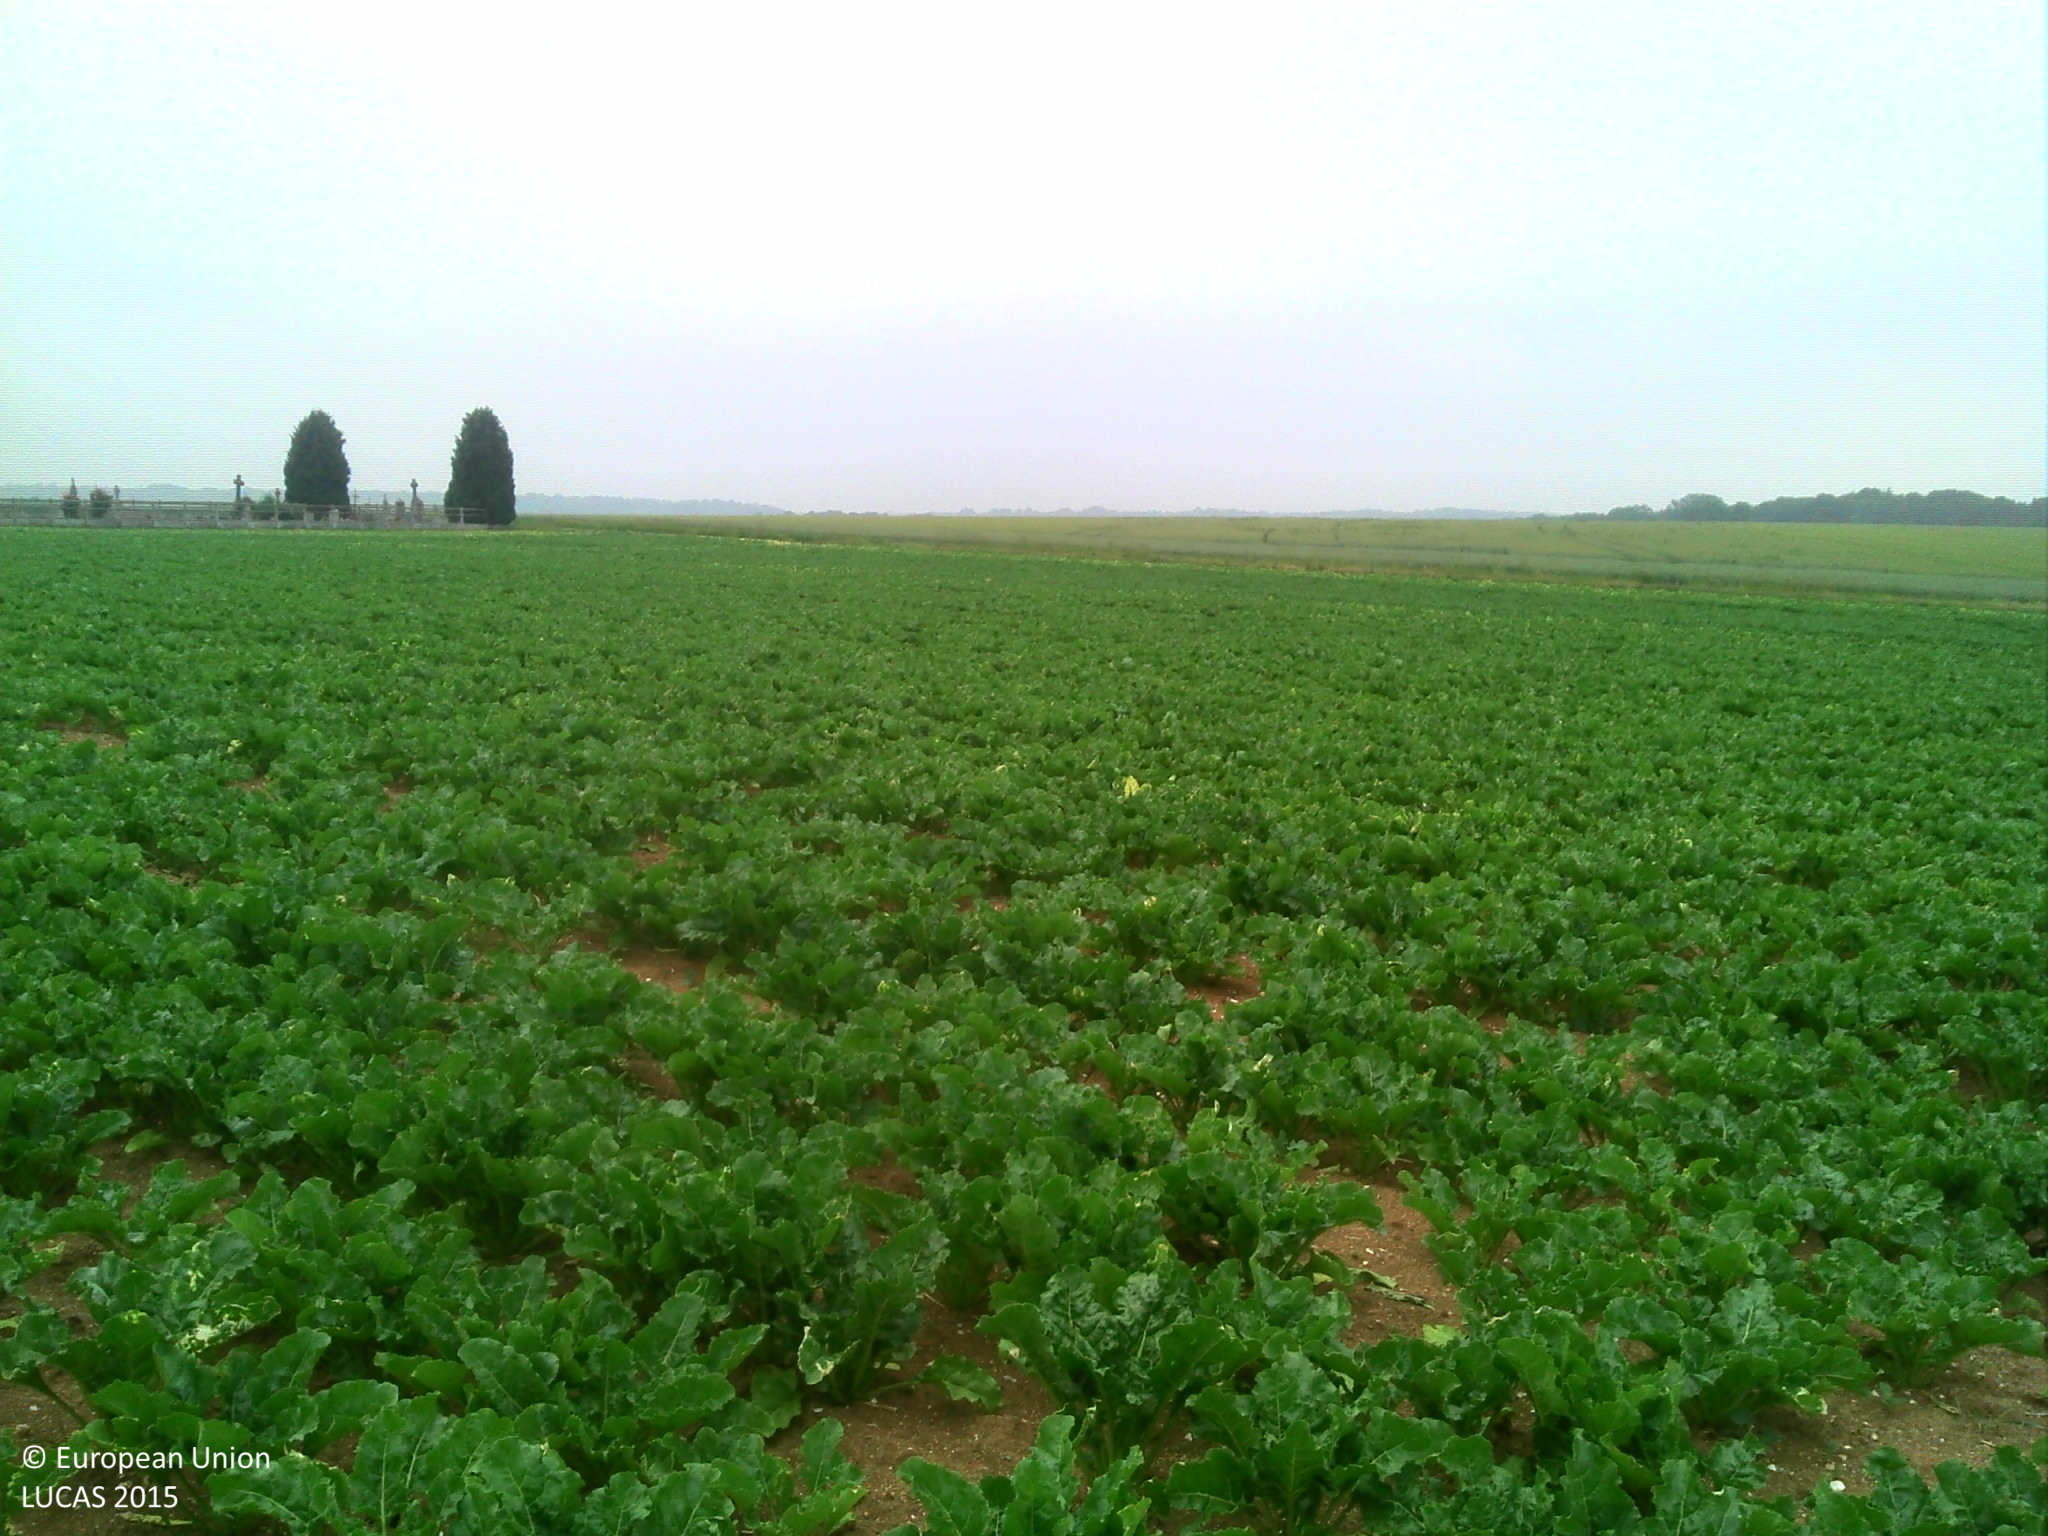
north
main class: Cropland
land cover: Sugar beet
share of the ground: > 75 %
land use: Agriculture (excluding fallow land and kitchen gardens)
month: June
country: FR
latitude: 49.8077
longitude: 2.1905
